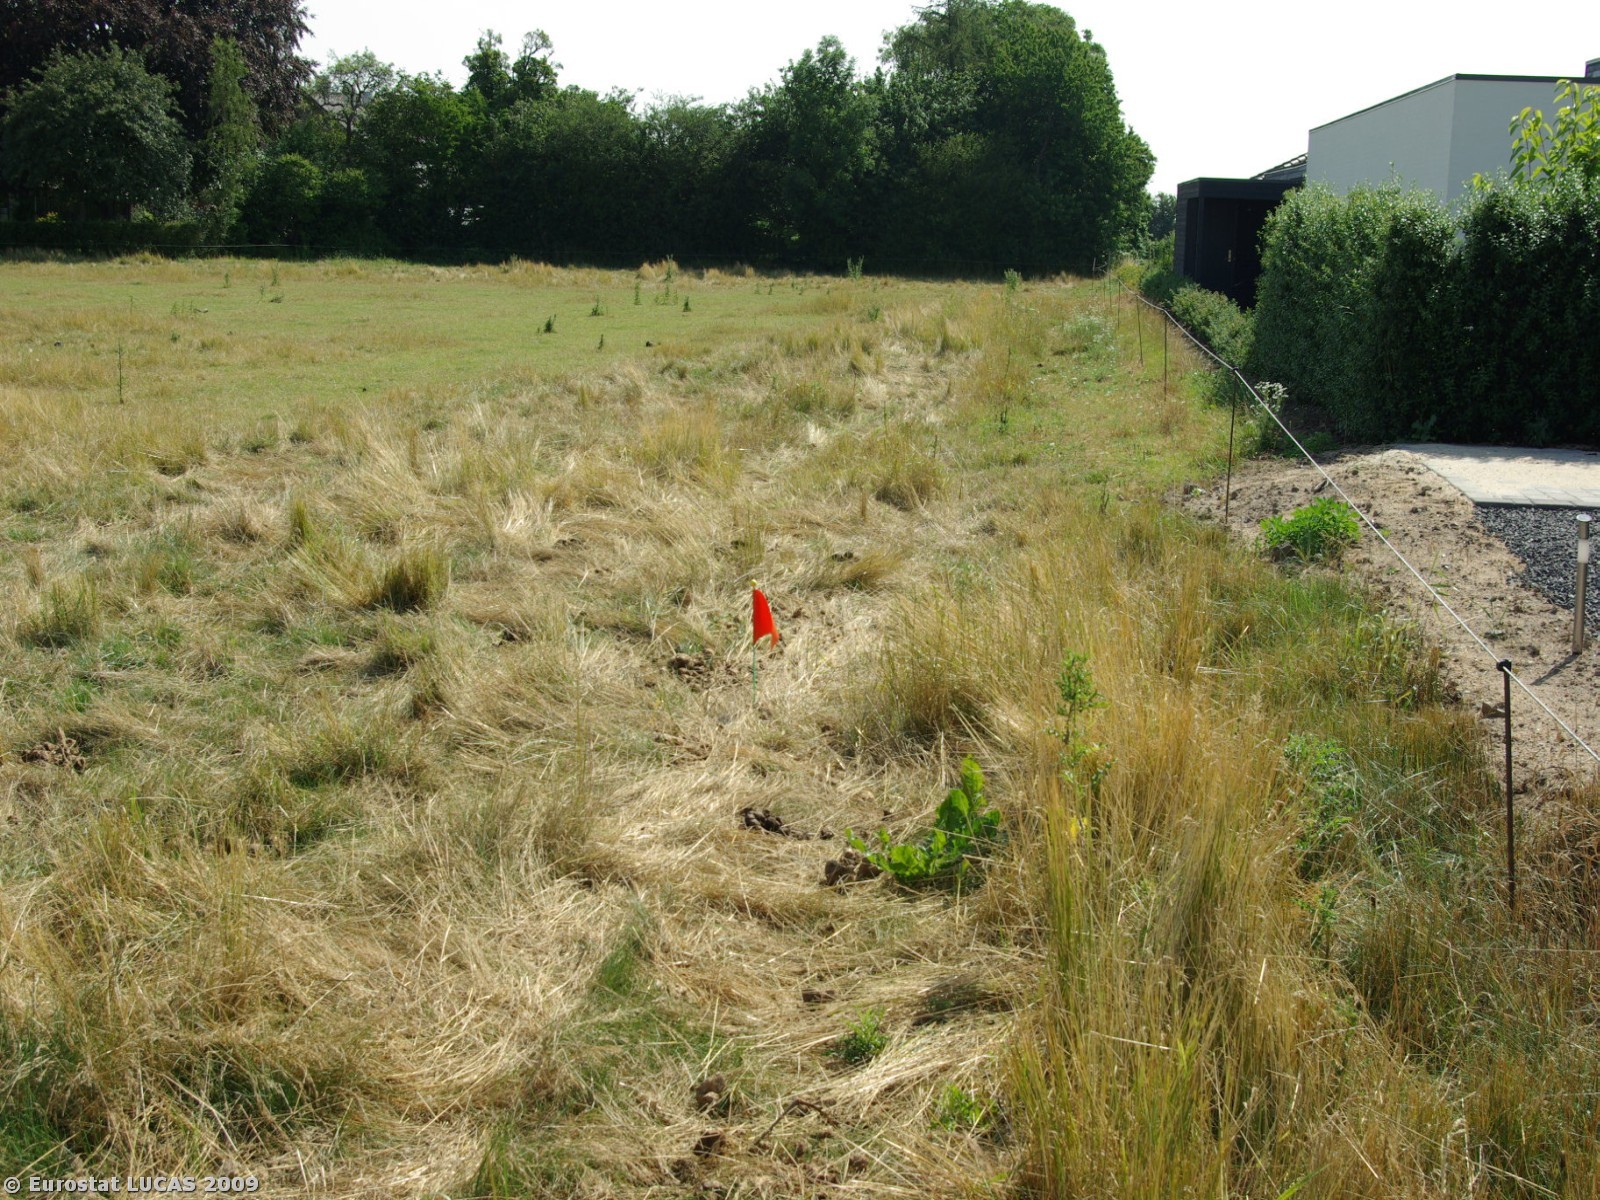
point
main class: Grassland
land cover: Grassland without tree/shrub cover
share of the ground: > 75 %
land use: Agriculture (excluding fallow land and kitchen gardens)
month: July
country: DK
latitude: 54.9472
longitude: 9.7036
